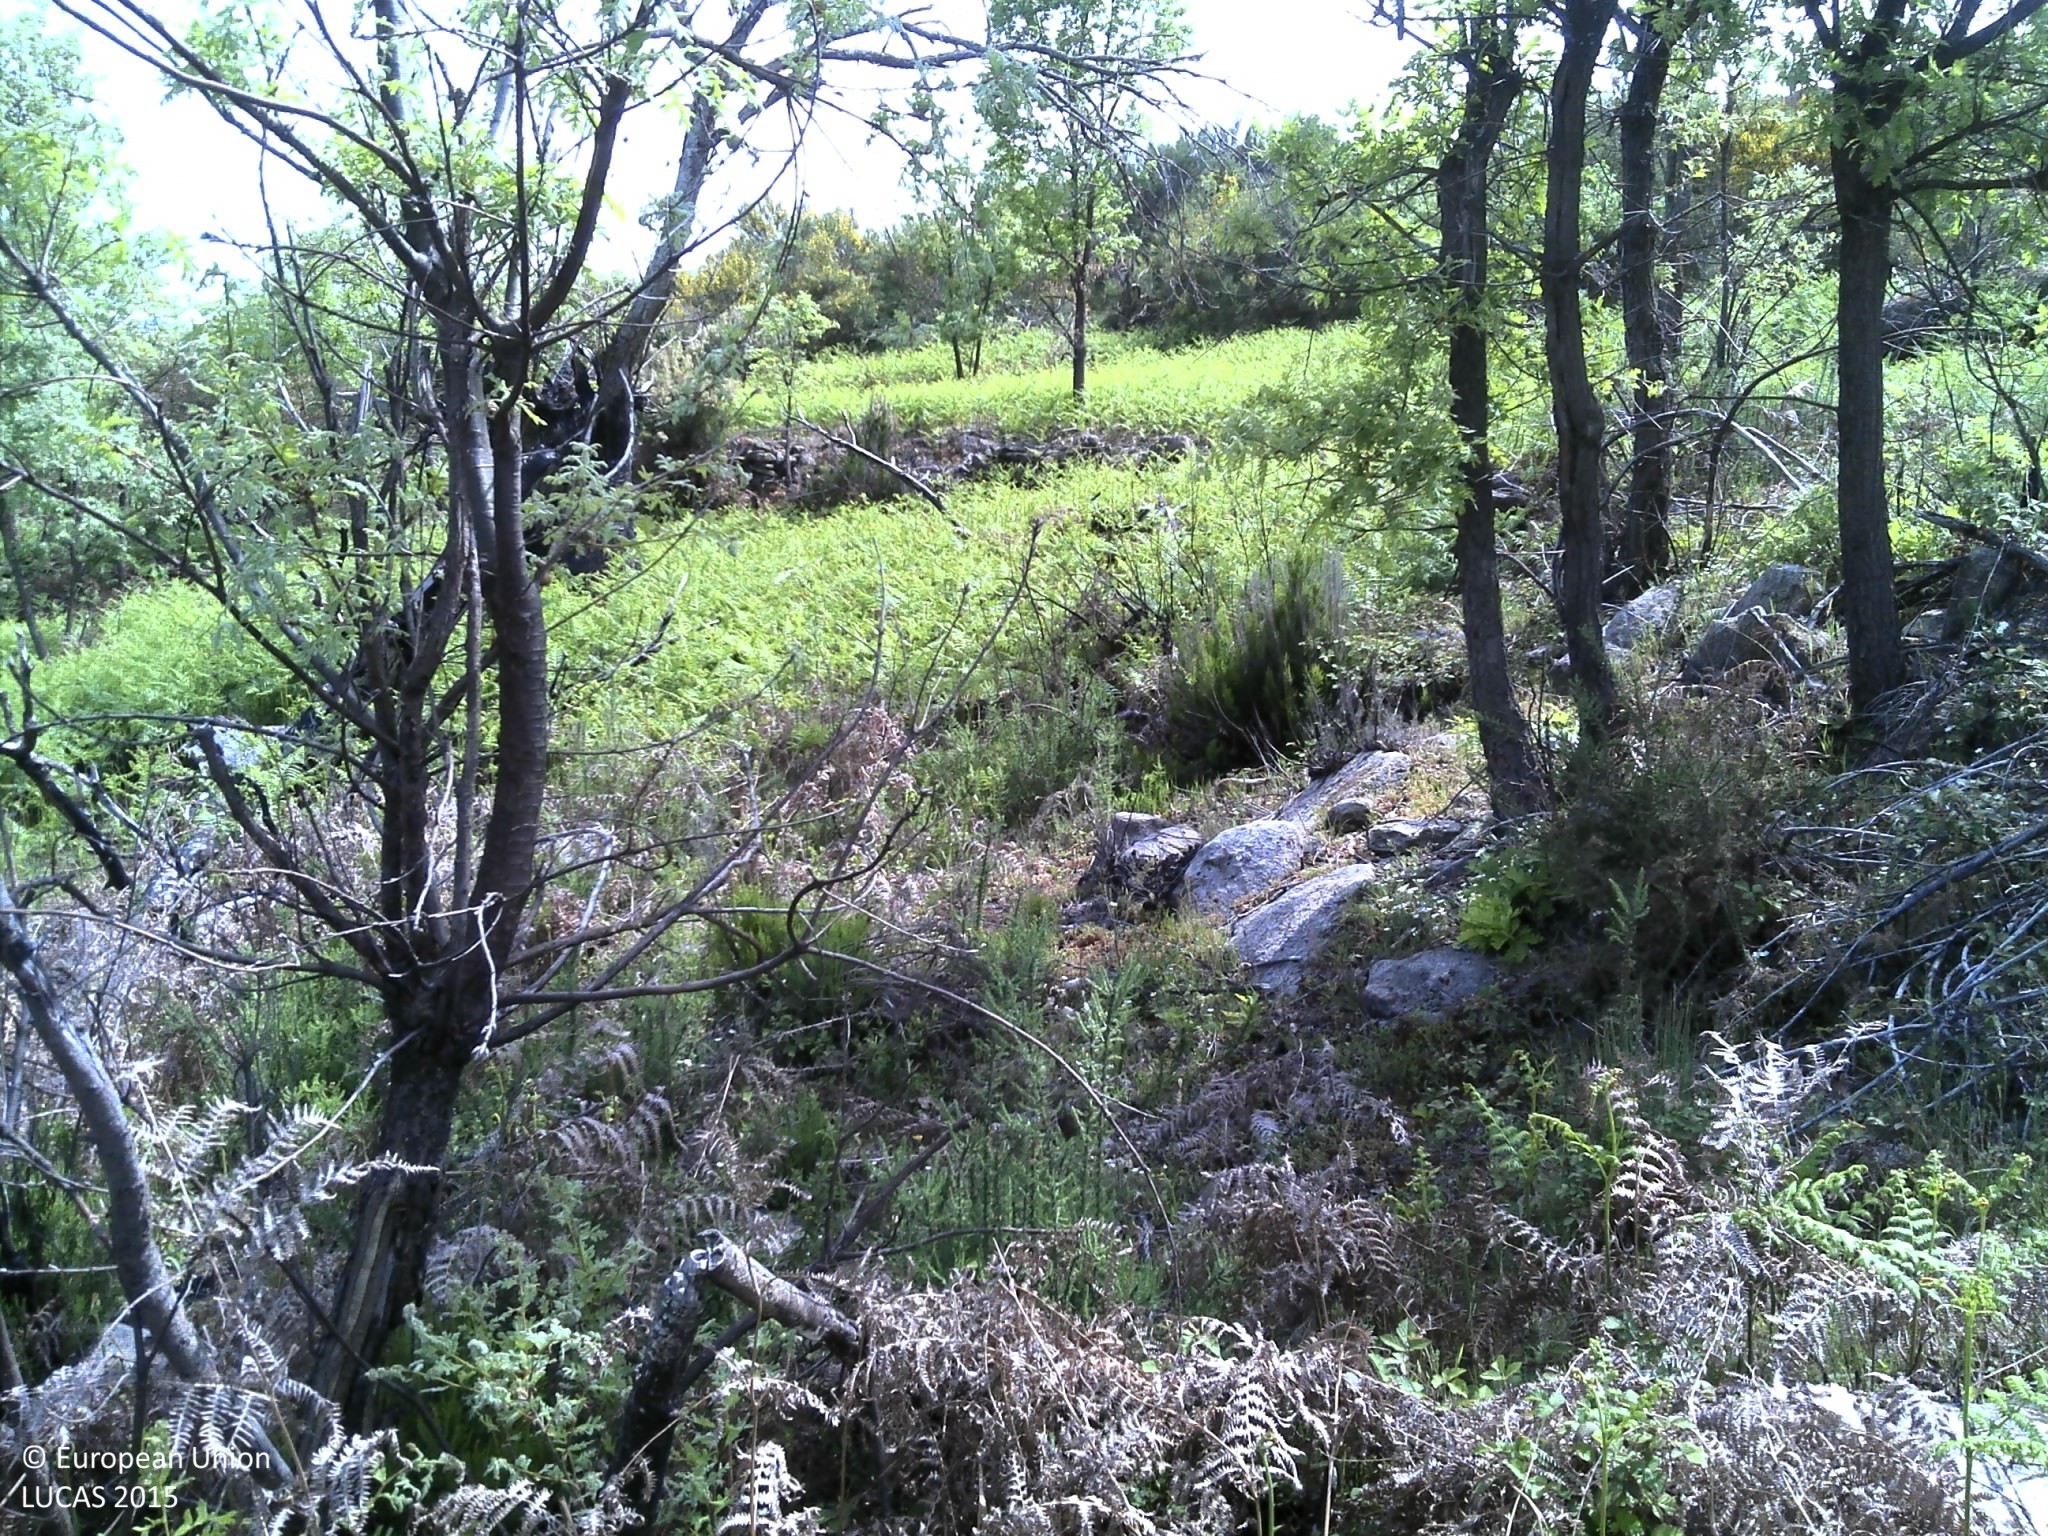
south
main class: Shrubland
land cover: Shrubland with sparse tree cover
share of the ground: 50 - 75 %
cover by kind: shrubs 70 %, unconsolidated bare surface 15 %, herbaceous plants 10 %, broadleaved forest trees 5 %
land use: Forestry
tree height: < 5 m
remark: Burnt area
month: May
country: PT
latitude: 41.9608
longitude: -7.0999
